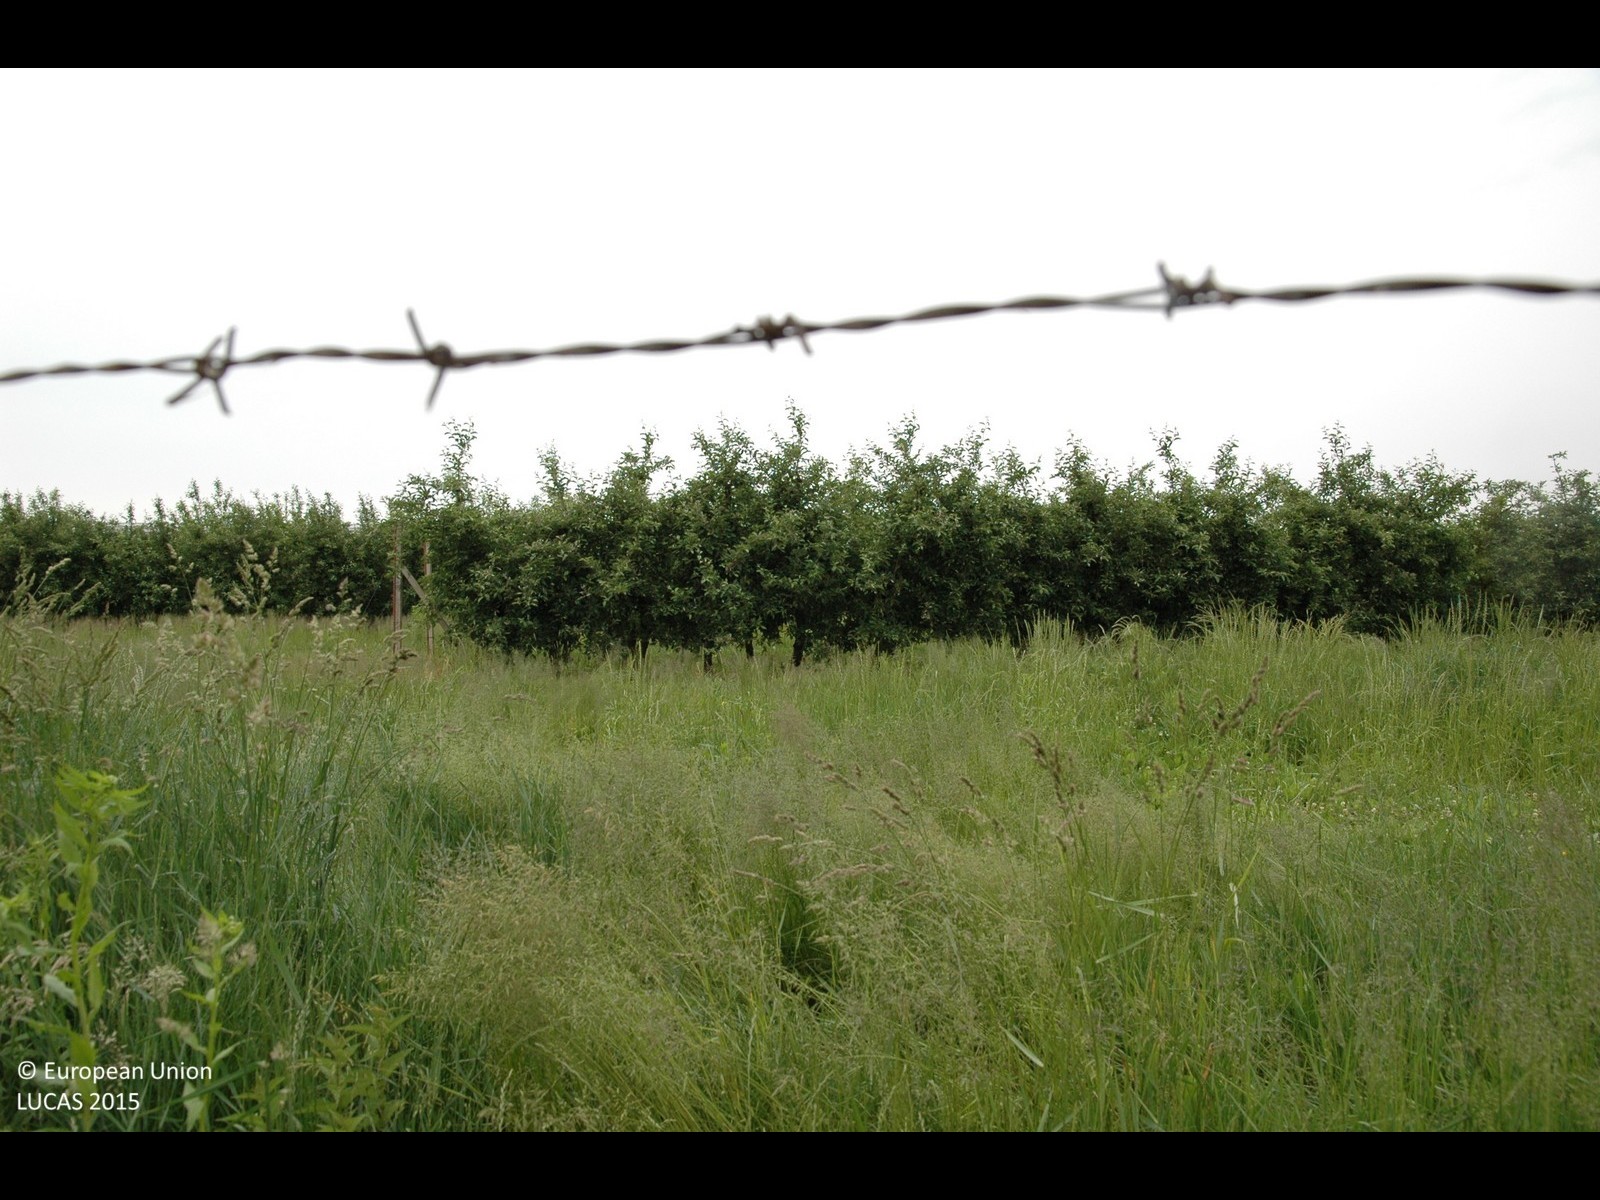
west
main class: Cropland
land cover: Apple fruit
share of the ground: 50 - 75 %
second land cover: Grassland without tree/shrub cover
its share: 50 - 75 %
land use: Agriculture (excluding fallow land and kitchen gardens)
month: May
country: HR
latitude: 46.4638
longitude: 16.4466
